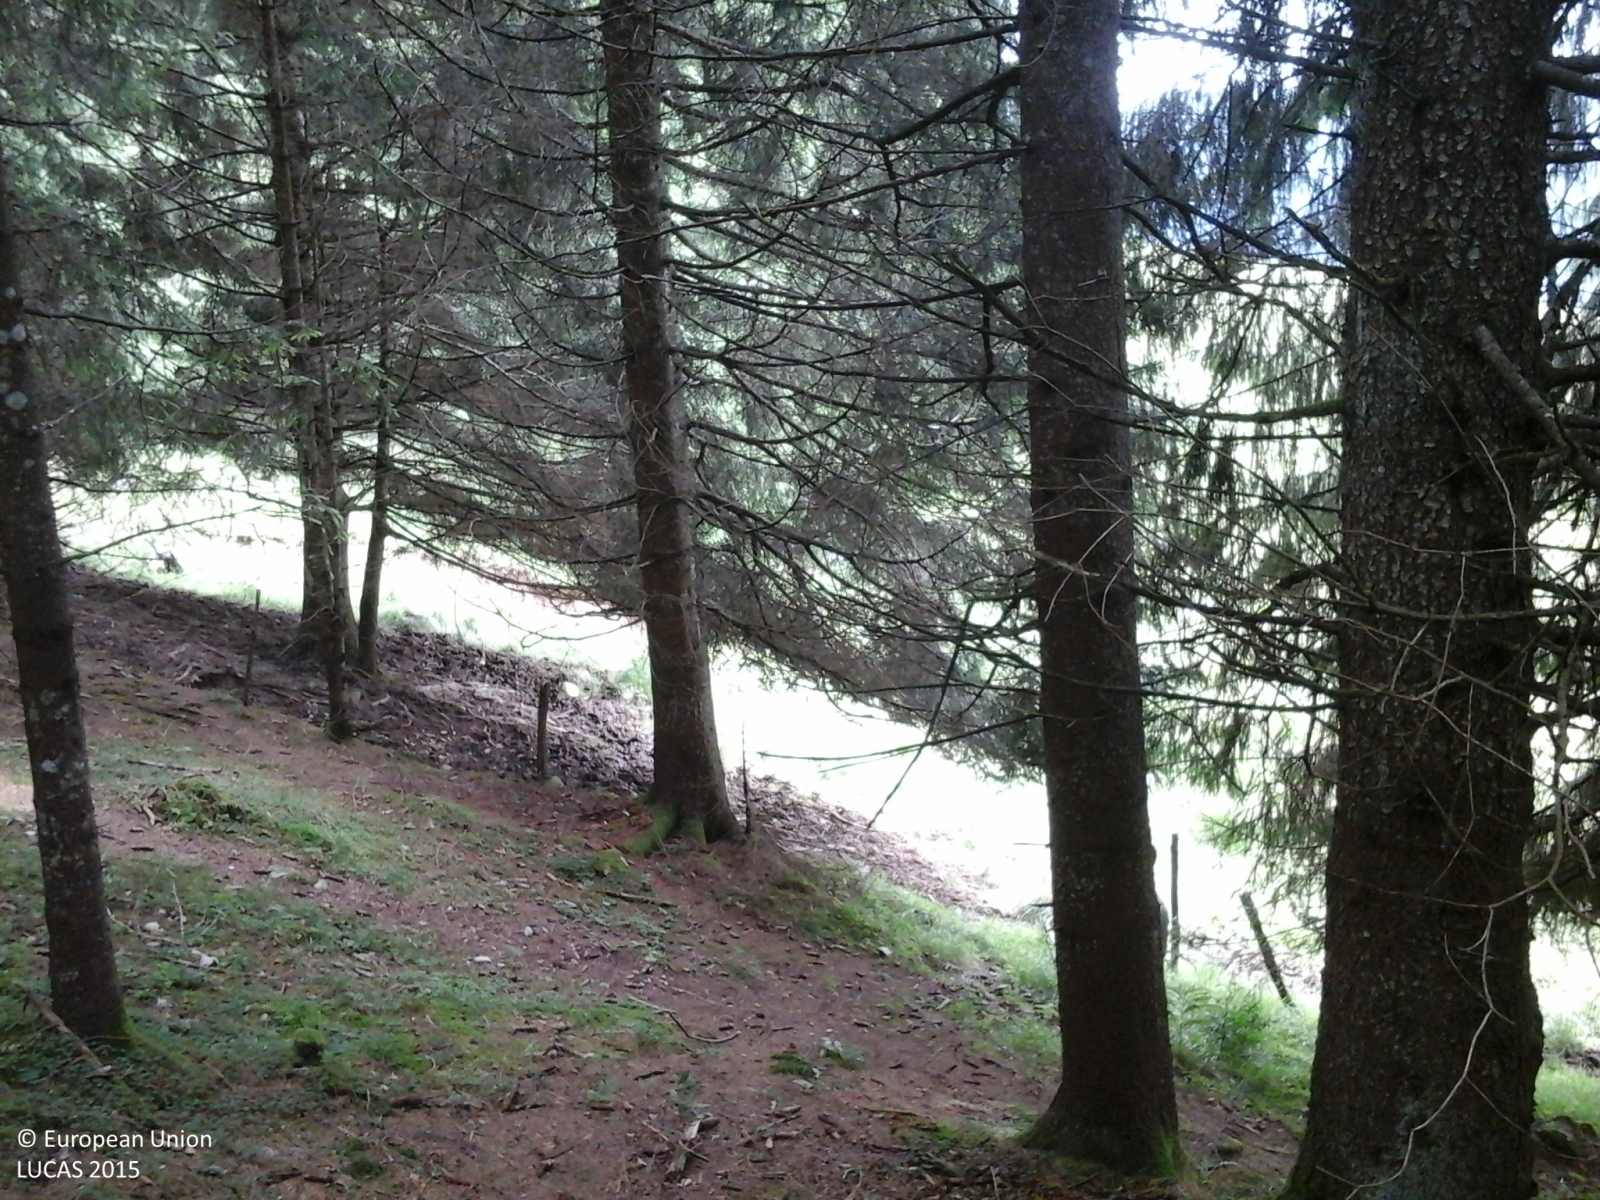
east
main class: Woodland
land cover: Spruce dominated mixed woodland
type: alpine coniferous forest
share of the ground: > 75 %
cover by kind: coniferous forest trees 75 %, broadleaved forest trees 25 %
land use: Semi-natural and natural areas not in use
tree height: > 5 m
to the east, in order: Spruce dominated mixed woodland; Fences; Grassland without tree/shrub cover; Spruce dominated coniferous woodland; Grassland without tree/shrub cover; Spruce dominated coniferous woodland; Grassland without tree/shrub cover
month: June
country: IT
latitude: 46.0897
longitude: 12.4155
